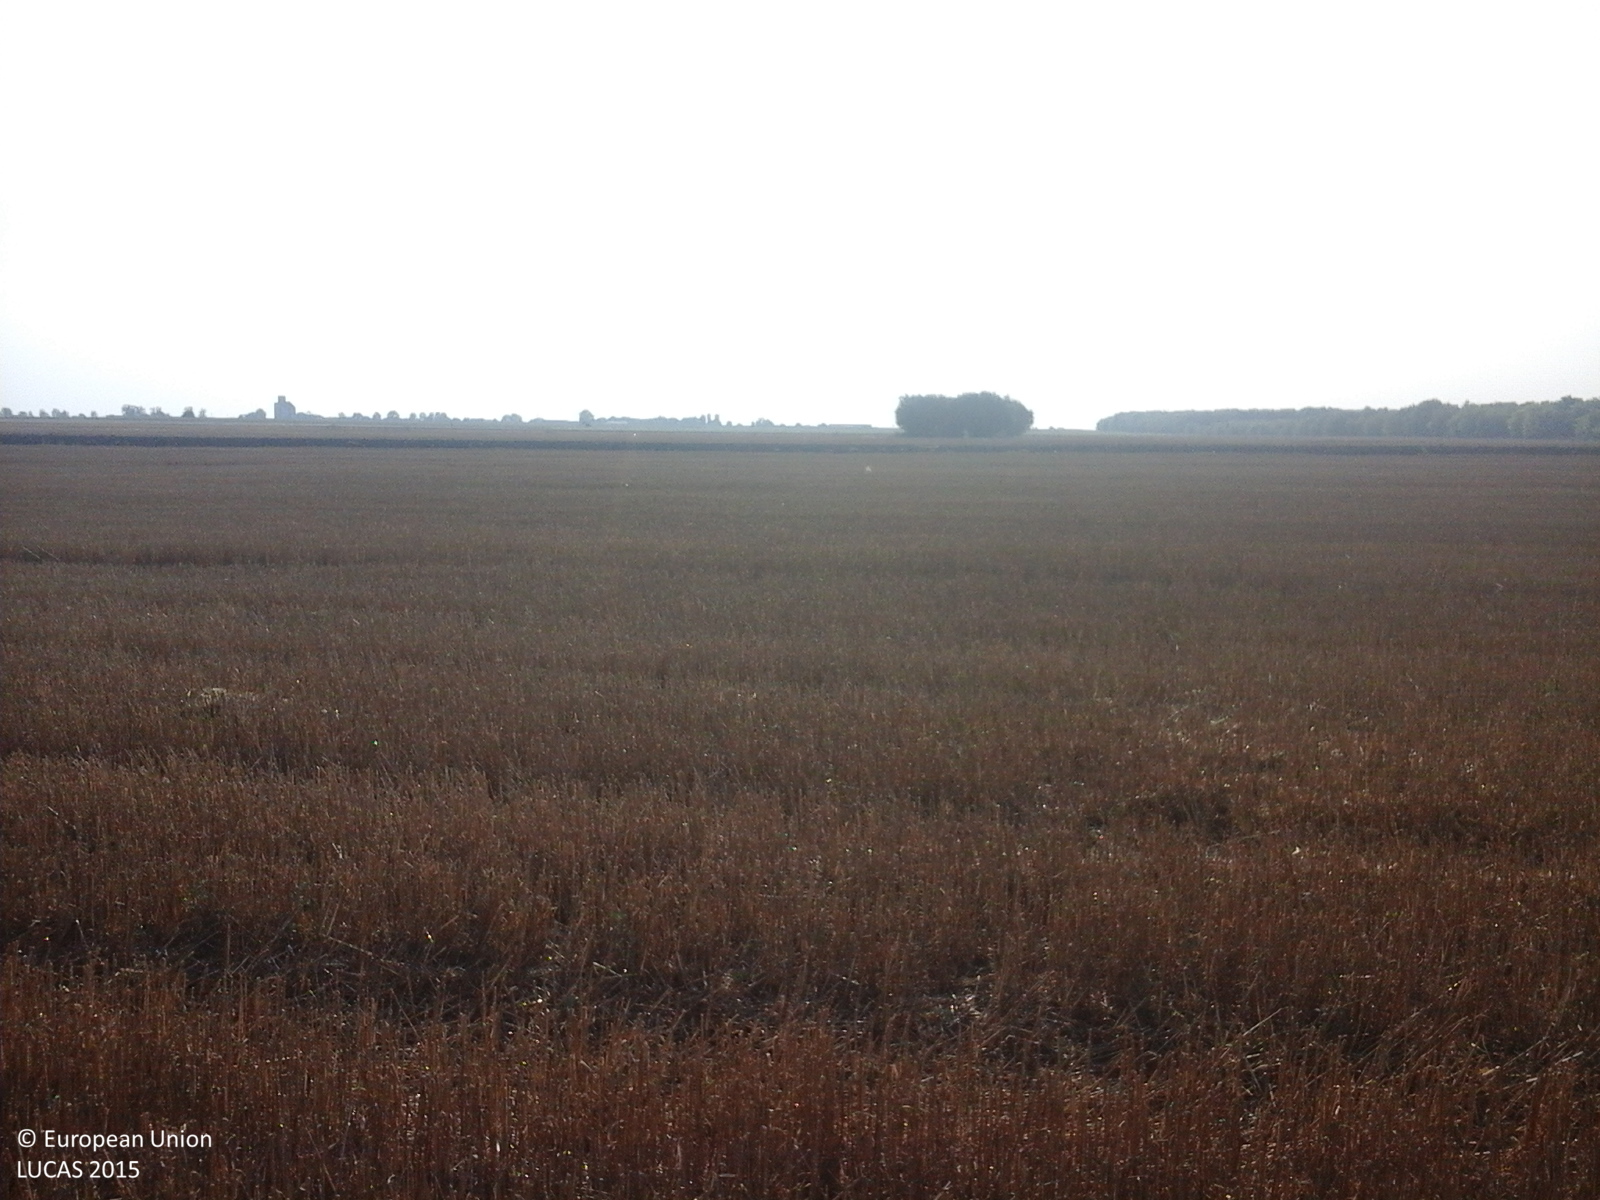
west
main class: Cropland
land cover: Common wheat
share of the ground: > 75 %
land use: Agriculture (excluding fallow land and kitchen gardens)
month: August
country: RO
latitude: 44.0582
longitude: 28.2740
